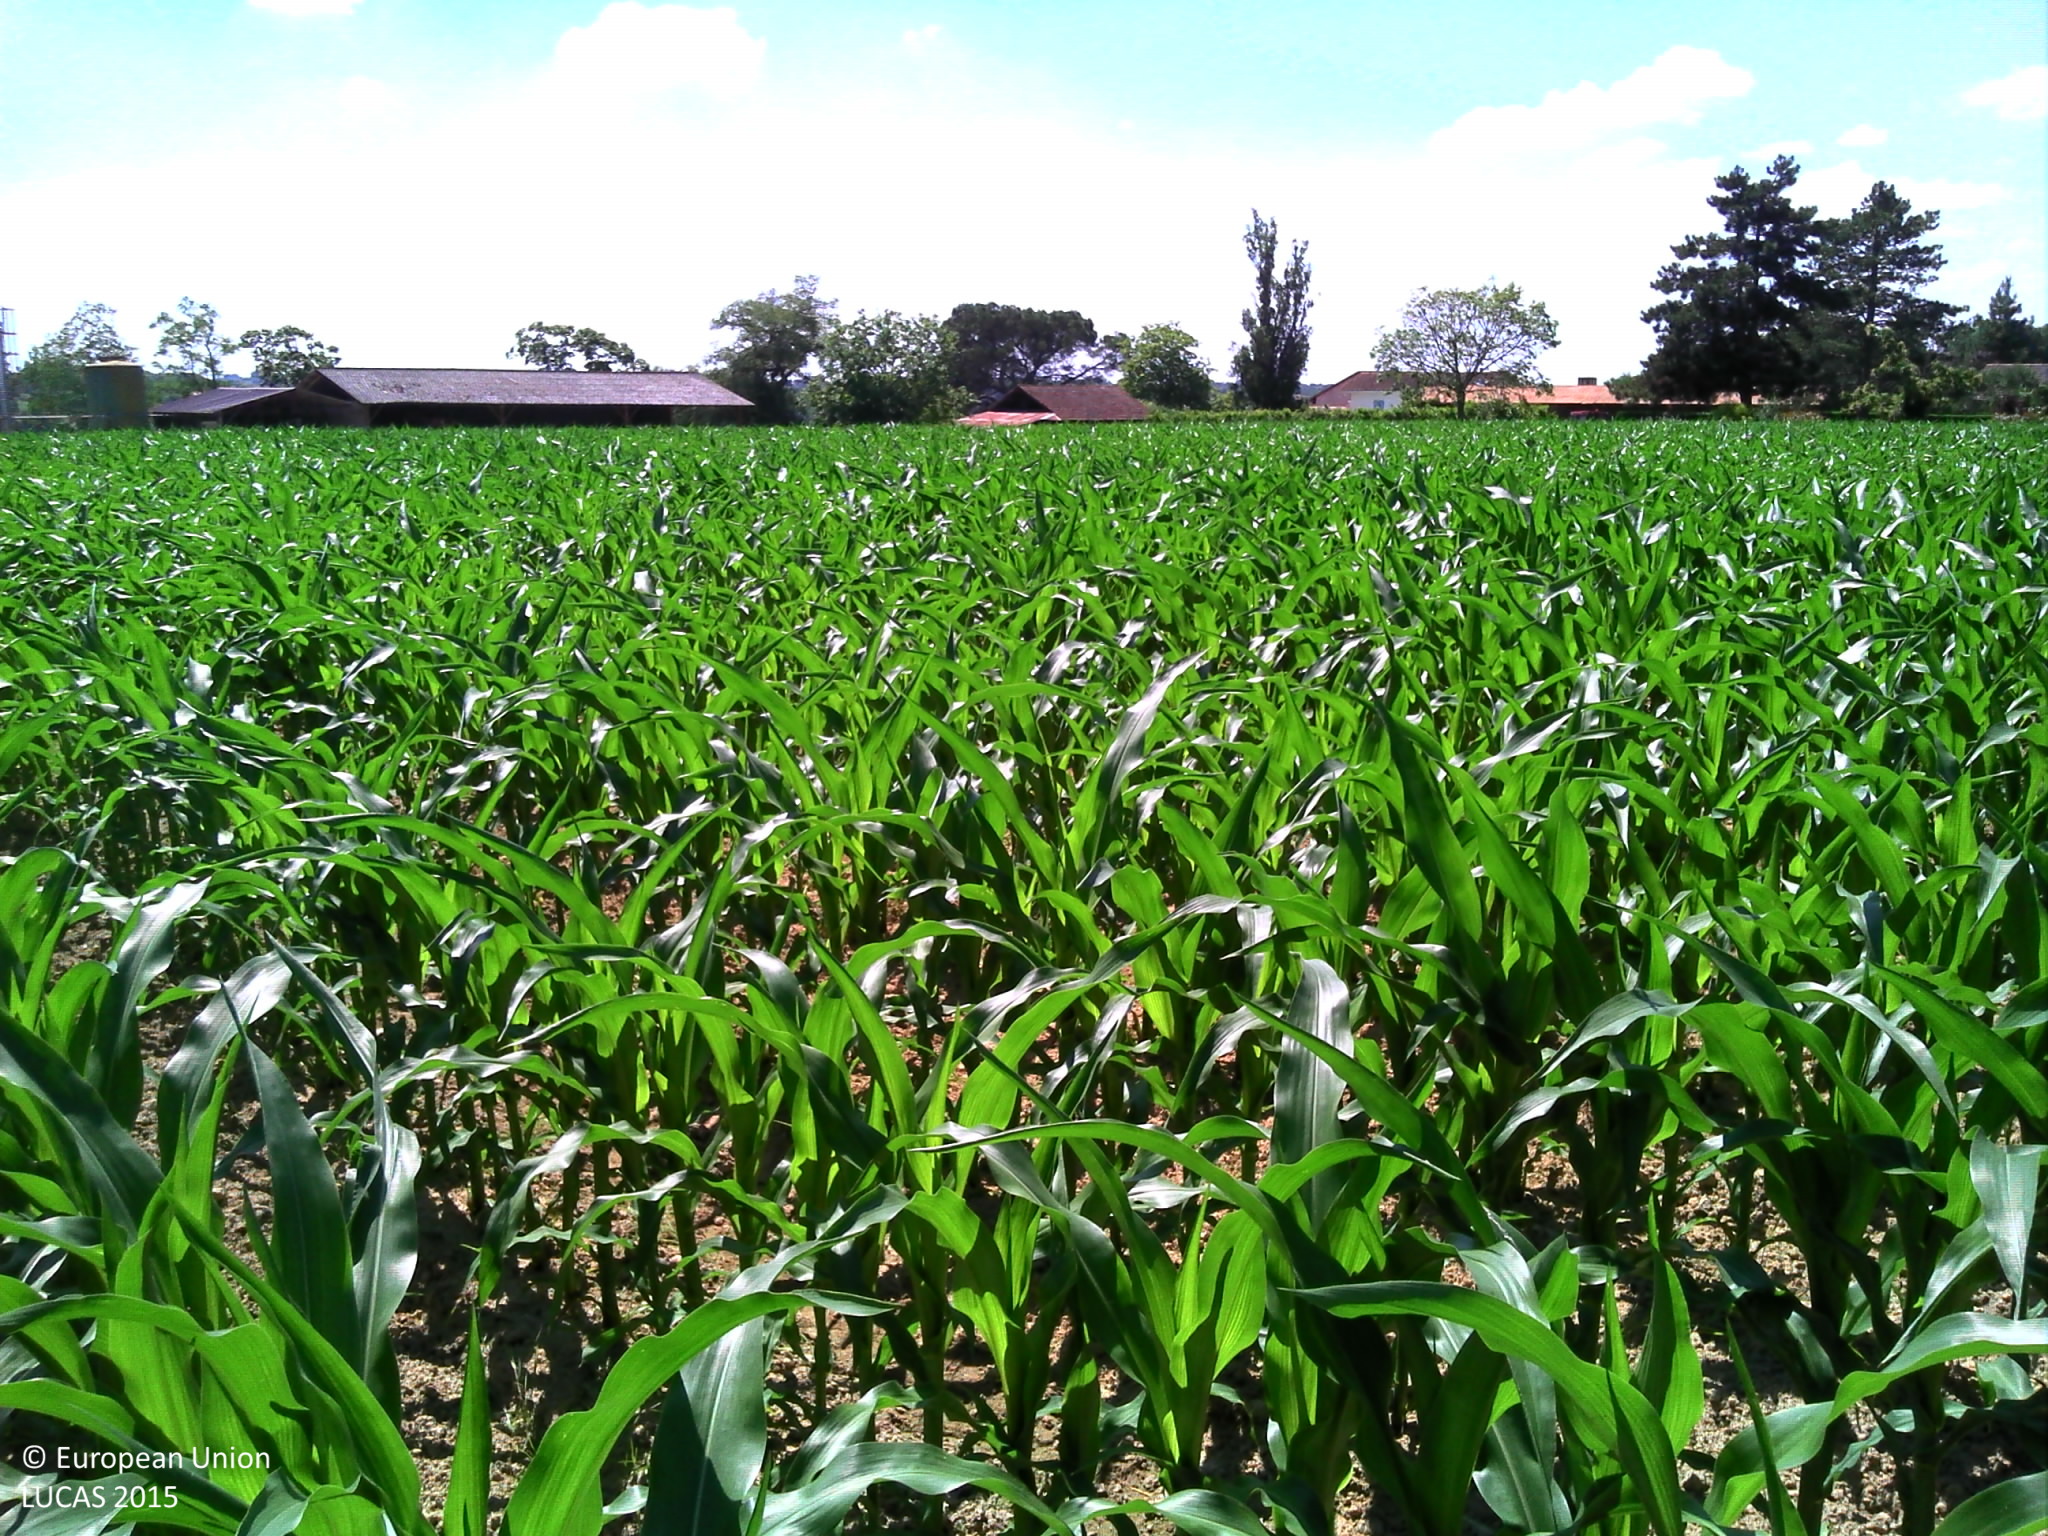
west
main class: Cropland
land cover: Maize
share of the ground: > 75 %
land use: Agriculture (excluding fallow land and kitchen gardens)
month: June
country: FR
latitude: 43.6691
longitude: -0.3401
